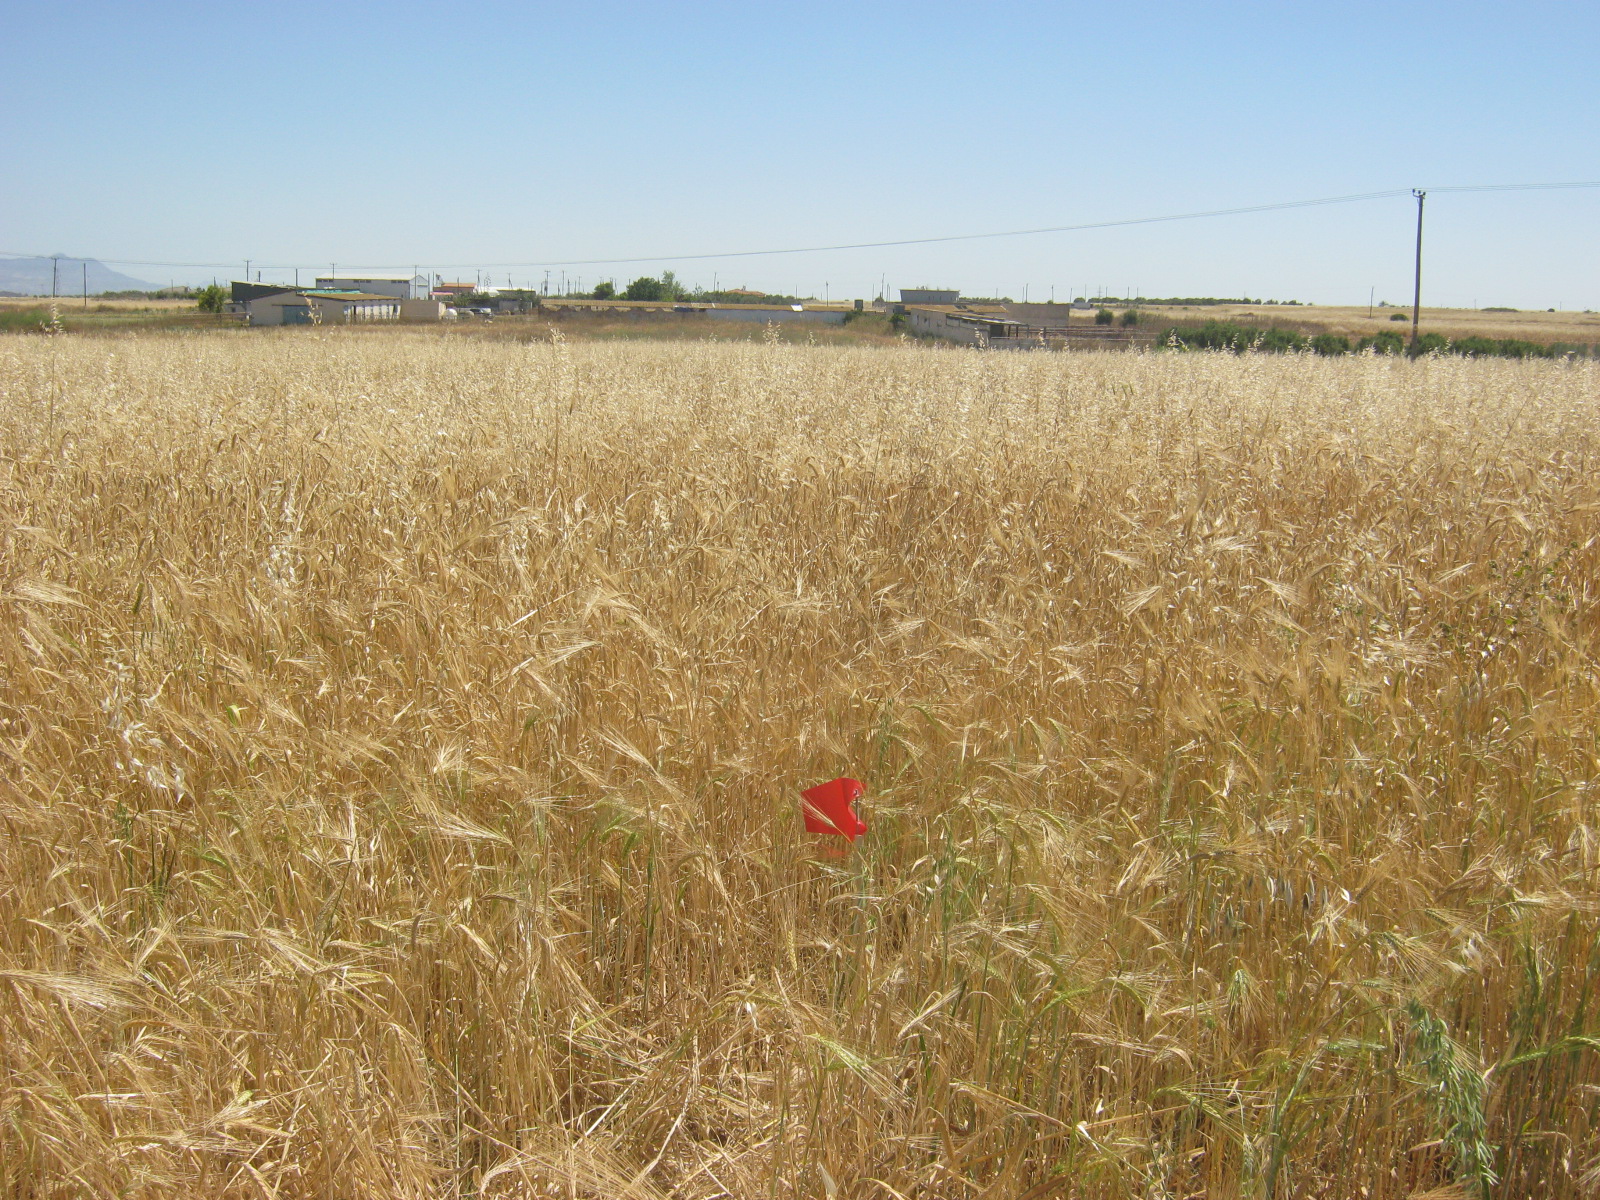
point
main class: Cropland
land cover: Barley
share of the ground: > 75 %
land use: Agriculture (excluding fallow land and kitchen gardens)
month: May
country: CY
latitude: 35.1309
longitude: 33.2220
